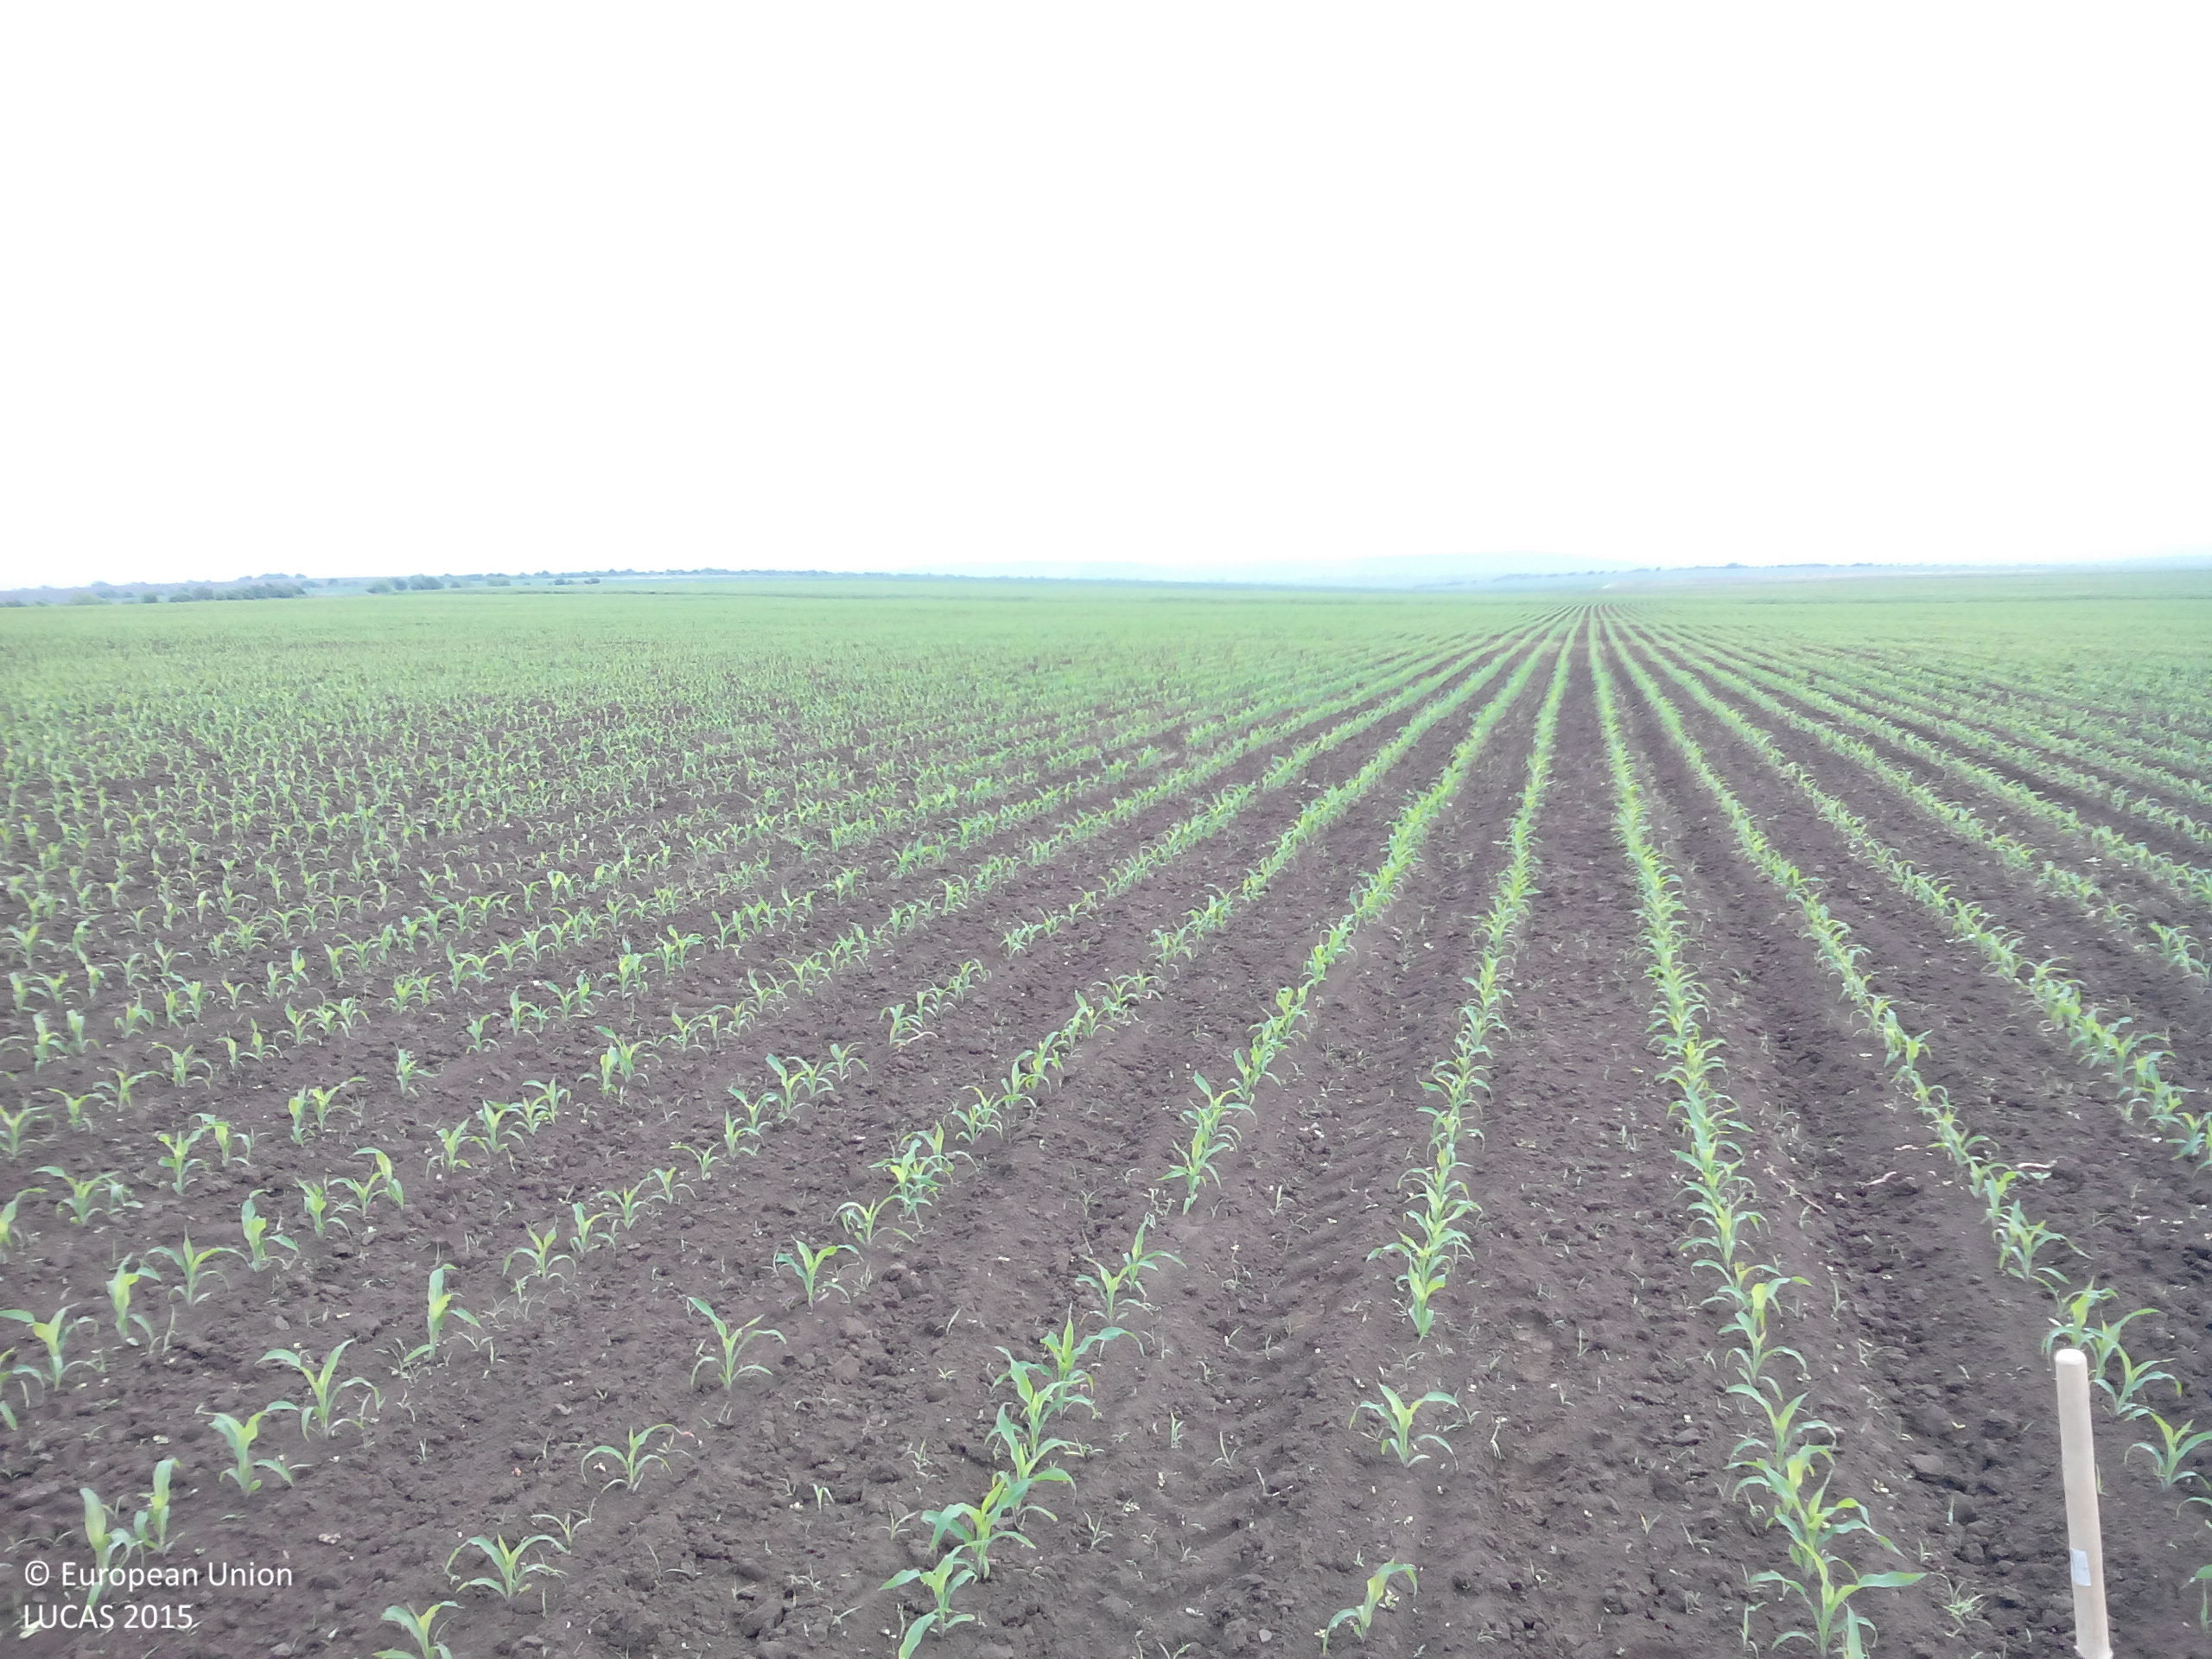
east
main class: Cropland
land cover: Maize
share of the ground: 10 - 25 %
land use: Agriculture (excluding fallow land and kitchen gardens)
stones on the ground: < 10 %
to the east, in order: Maize
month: May
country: BG
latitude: 43.6141
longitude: 23.7414
